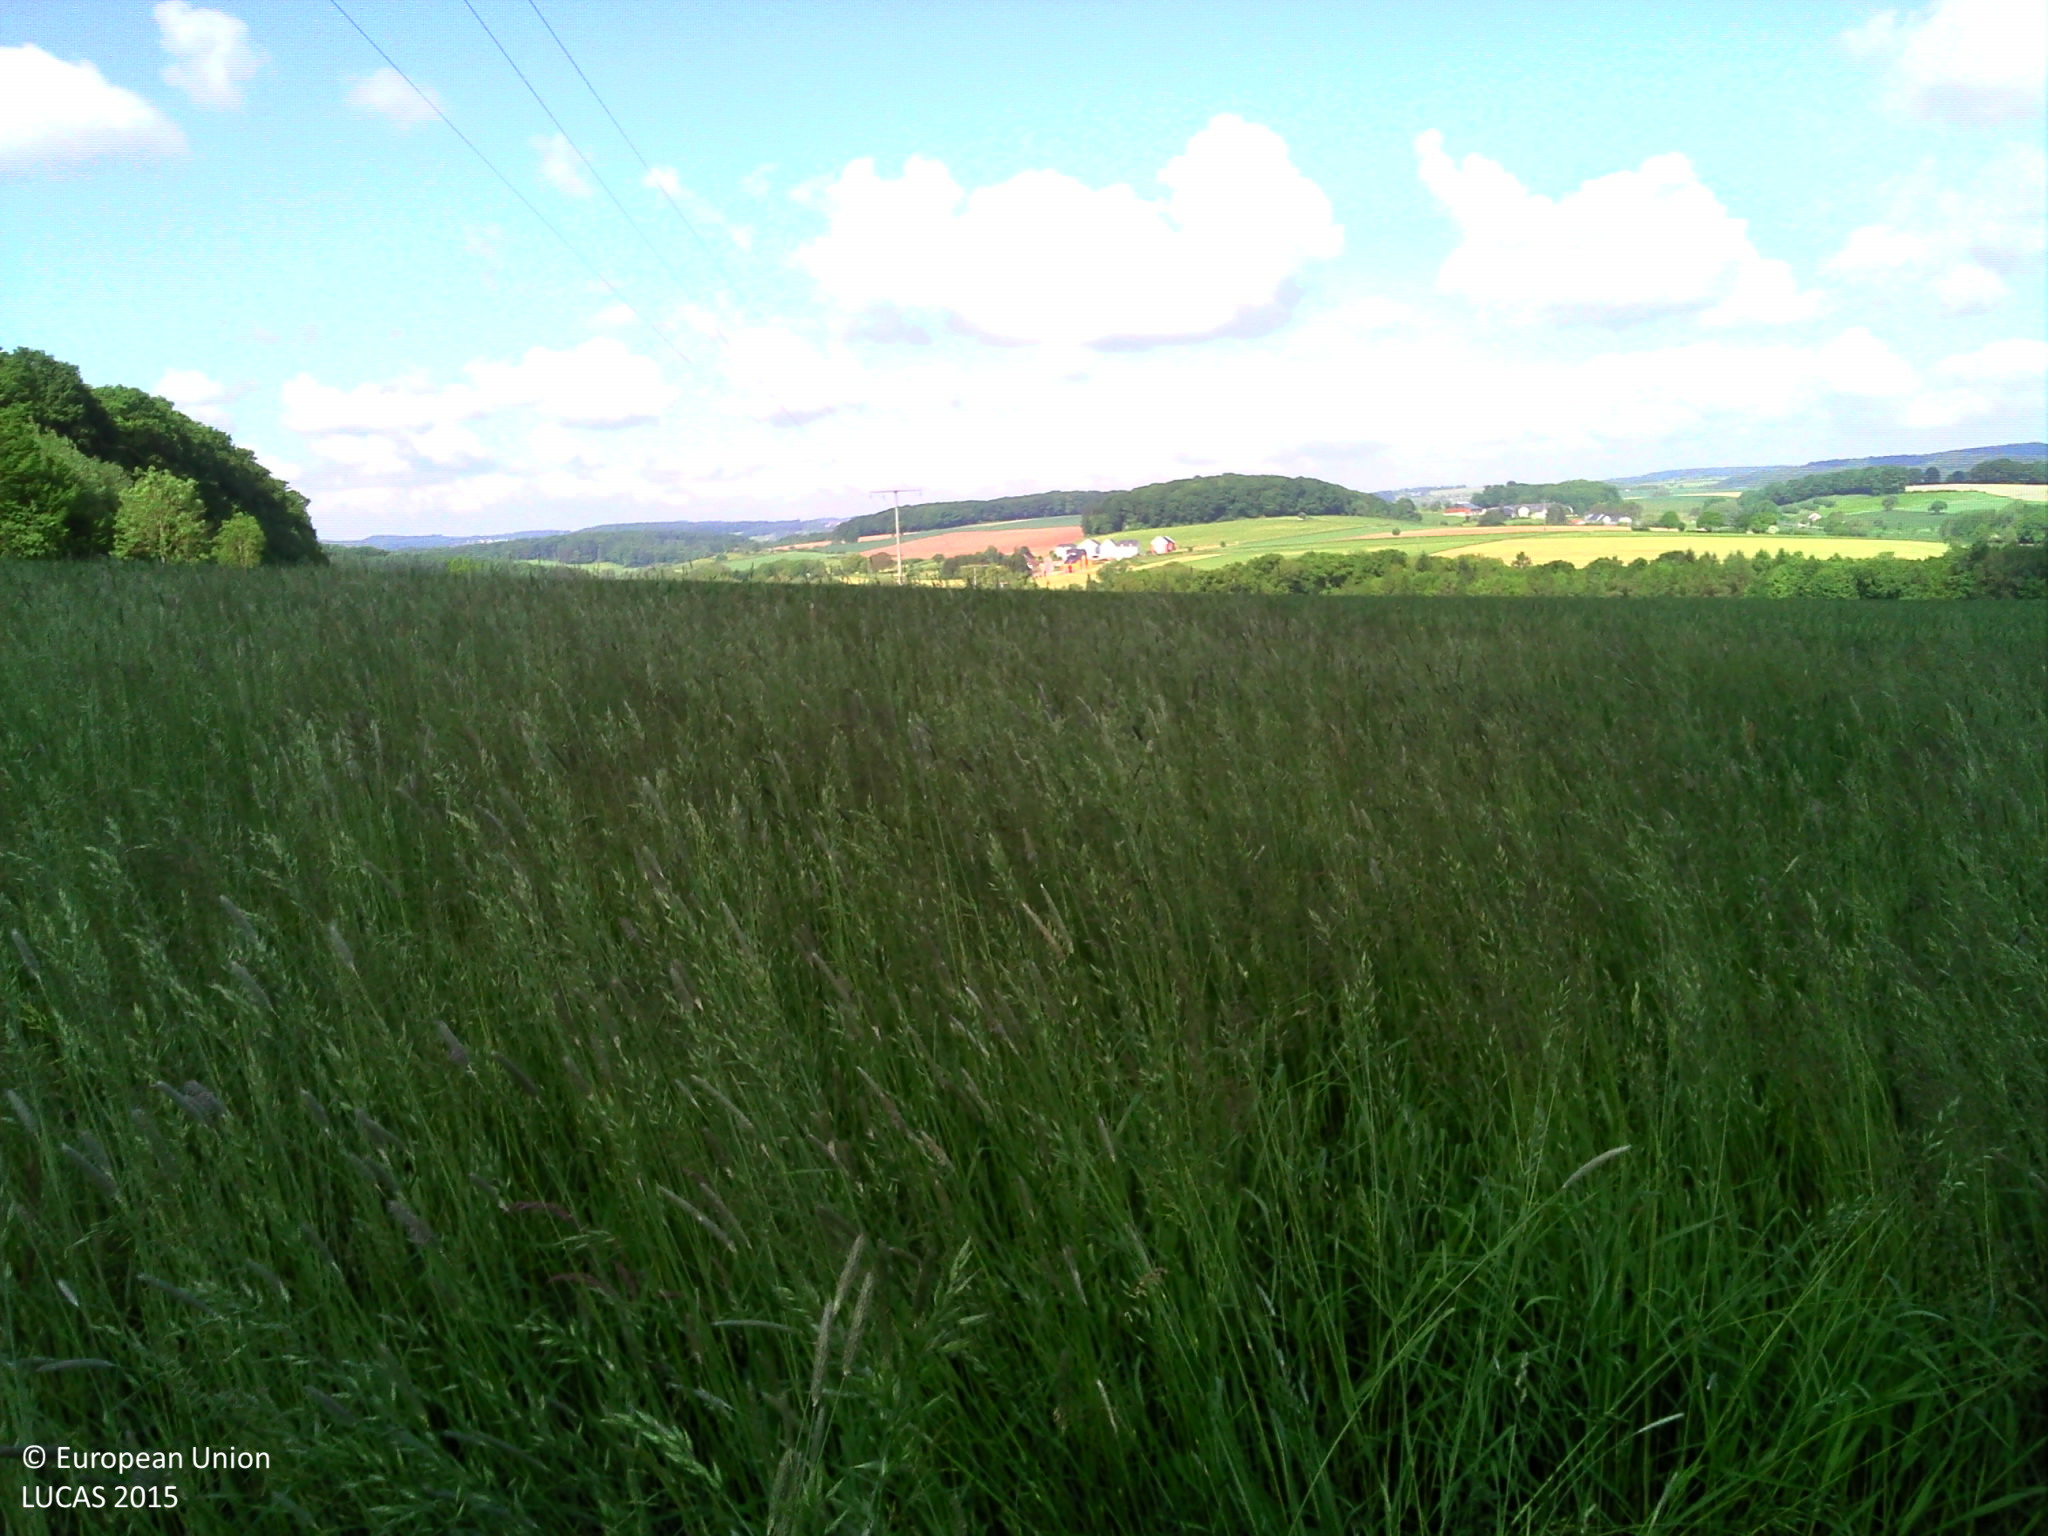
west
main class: Grassland
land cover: Grassland without tree/shrub cover
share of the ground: > 75 %
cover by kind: herbaceous plants 100 %
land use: Agriculture (excluding fallow land and kitchen gardens)
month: May
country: LU
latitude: 49.7119
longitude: 6.3523
